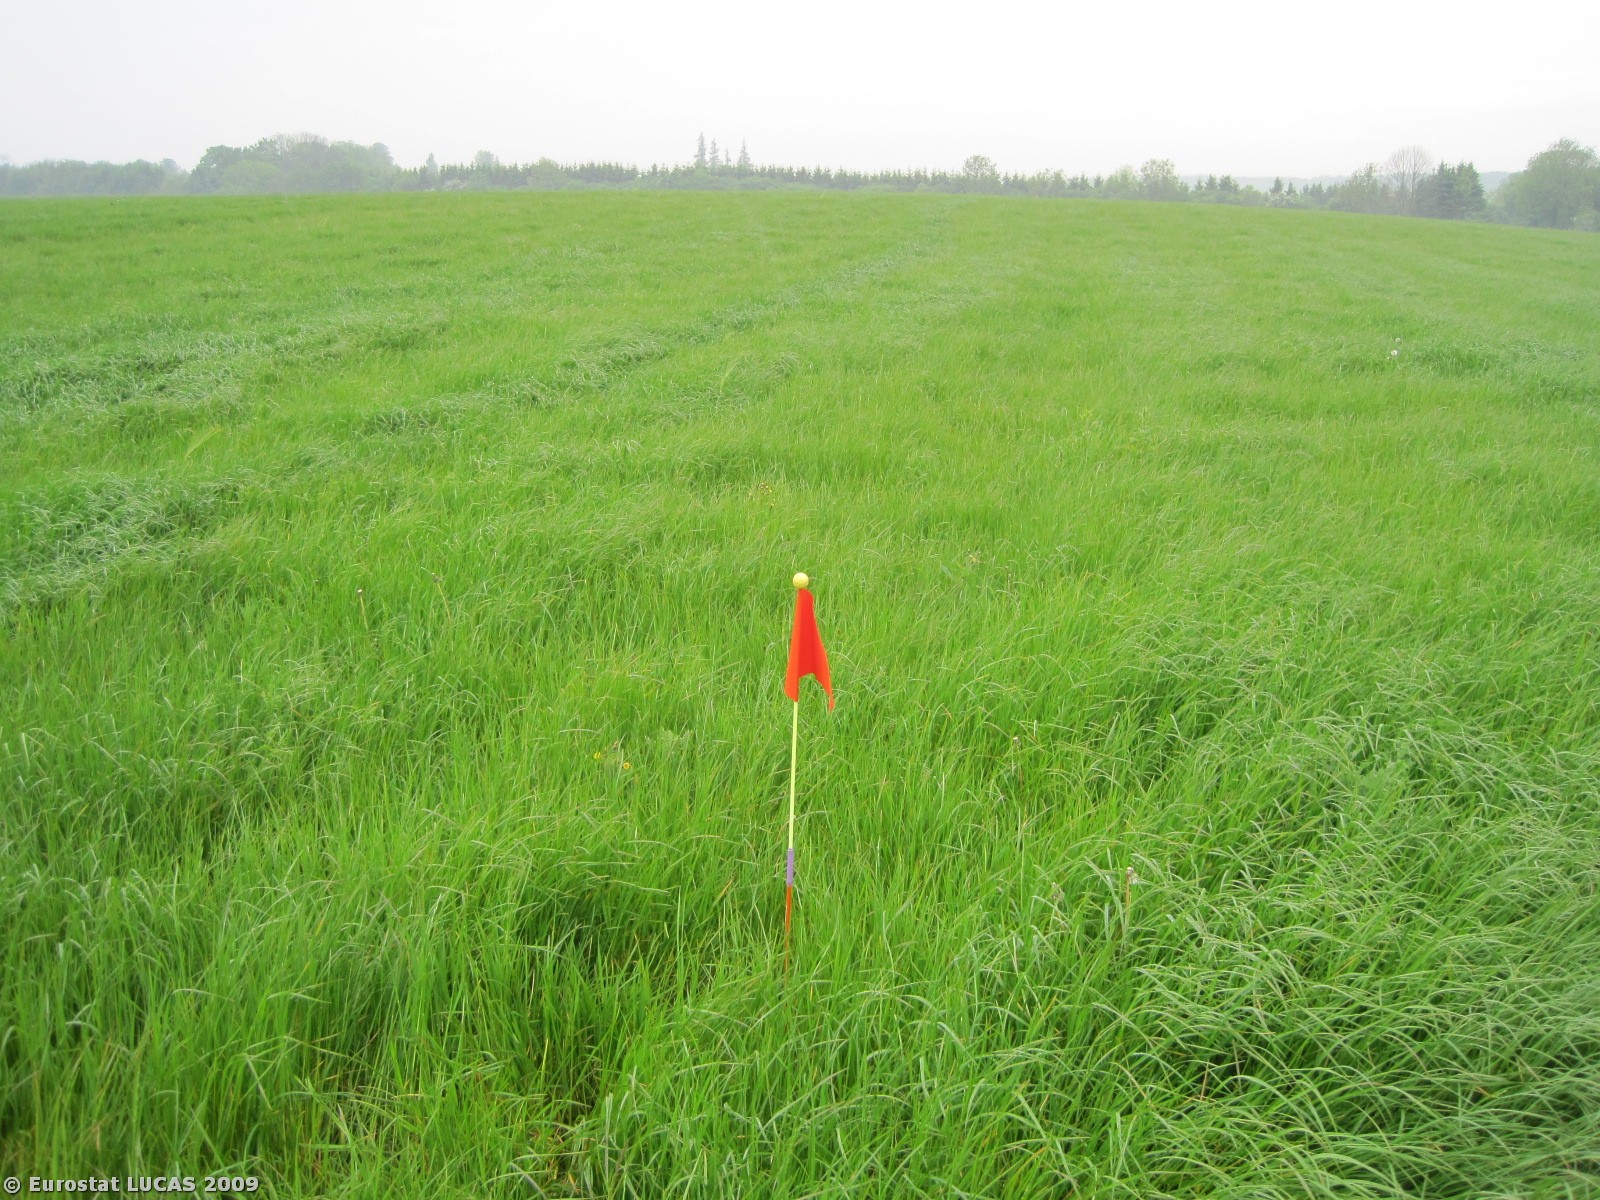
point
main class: Grassland
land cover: Grassland without tree/shrub cover
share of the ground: > 75 %
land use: Agriculture (excluding fallow land and kitchen gardens)
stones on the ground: < 10 %
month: May
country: DK
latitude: 56.3315
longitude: 9.8546
